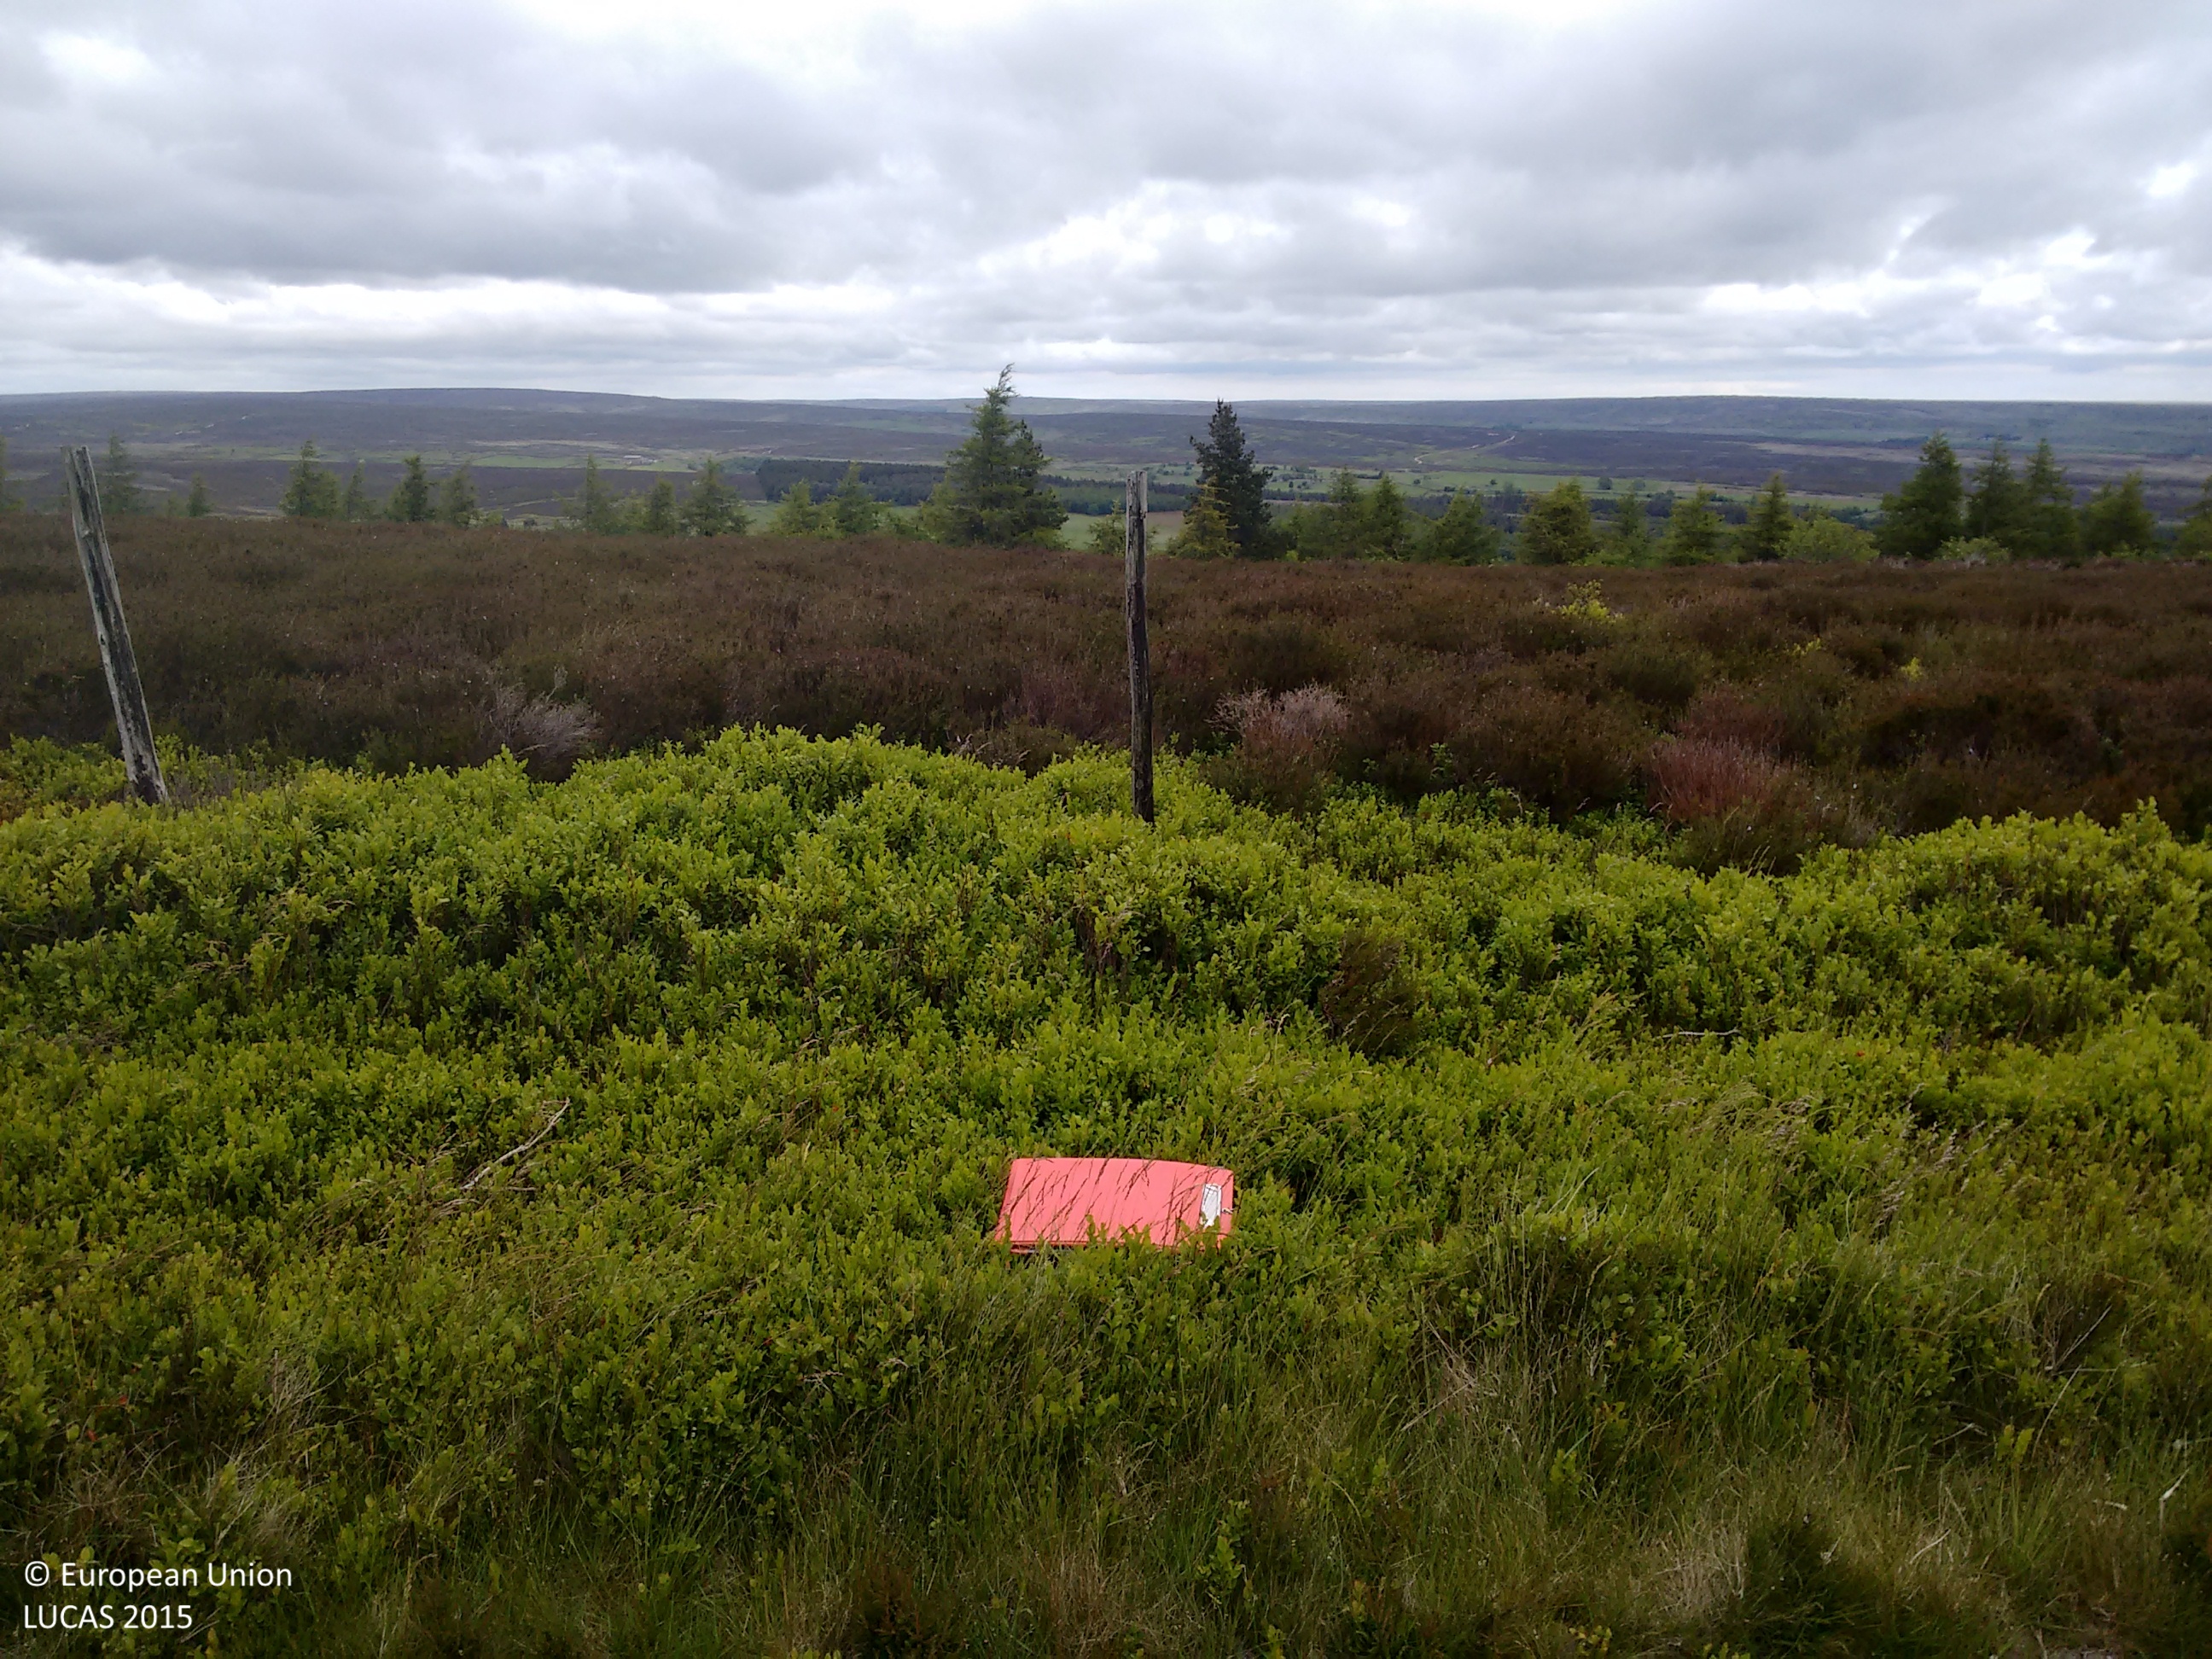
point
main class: Shrubland
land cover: Shrubland without tree cover
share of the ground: > 75 %
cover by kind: shrubs 100 %
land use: Semi-natural and natural areas not in use
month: June
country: GB
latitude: 54.3067
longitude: -1.0936
